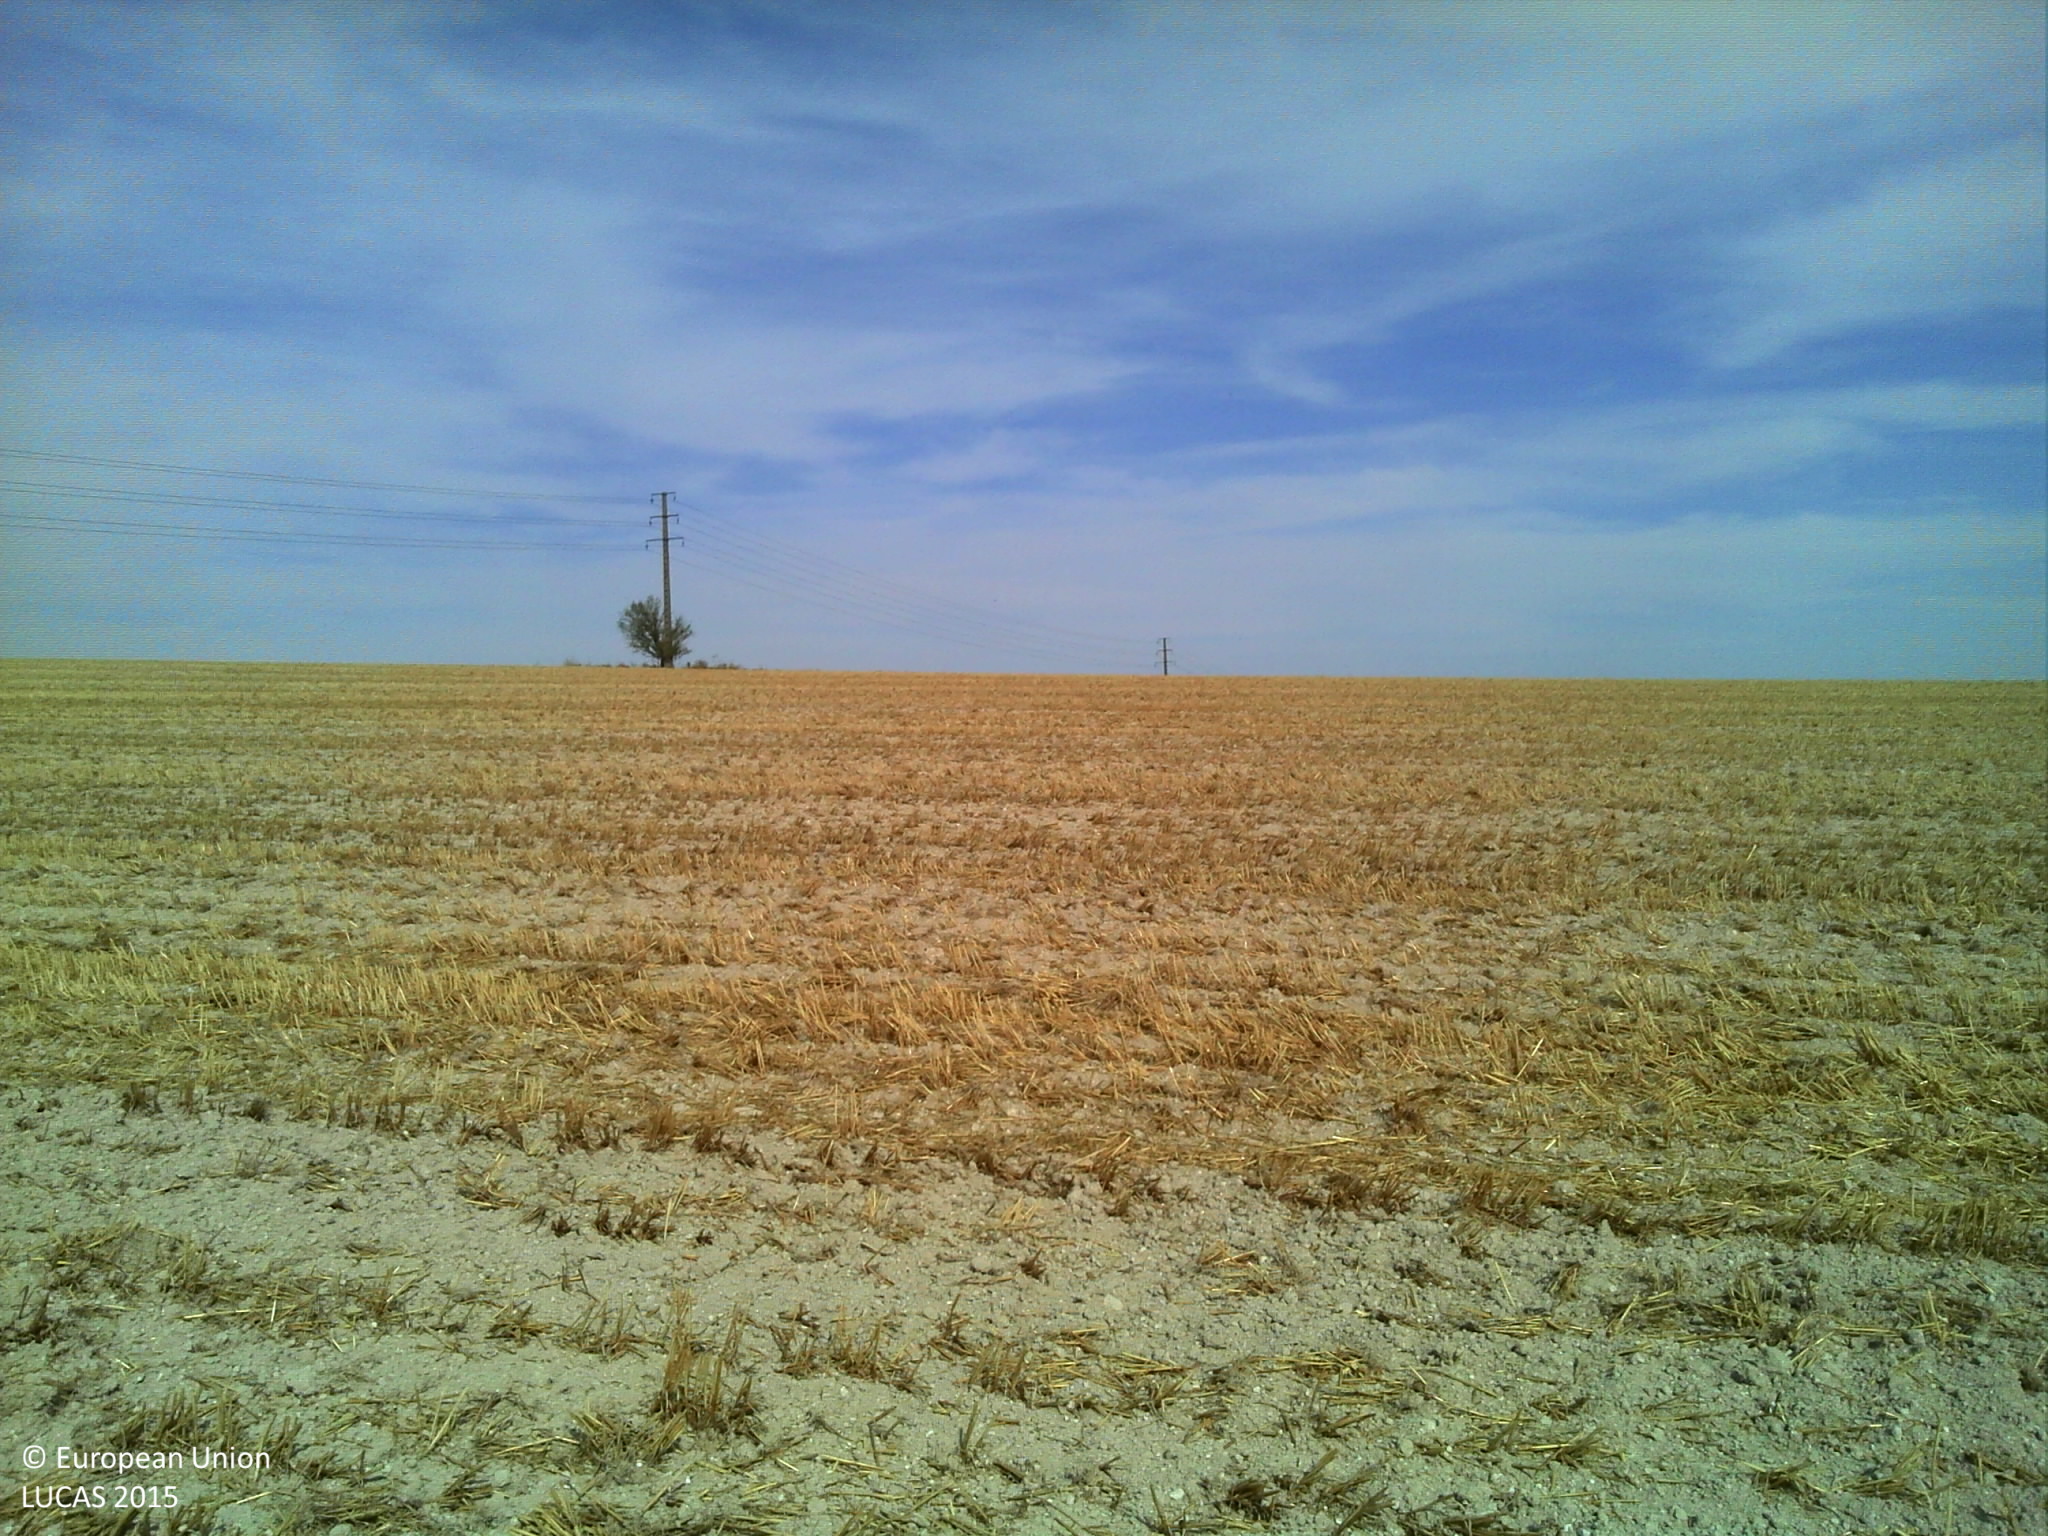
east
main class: Cropland
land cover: Common wheat
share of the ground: > 75 %
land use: Agriculture (excluding fallow land and kitchen gardens)
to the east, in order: Common wheat; Rape and turnip rape; Electric lines; Rape and turnip rape
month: August
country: FR
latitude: 49.2217
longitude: 4.1326
